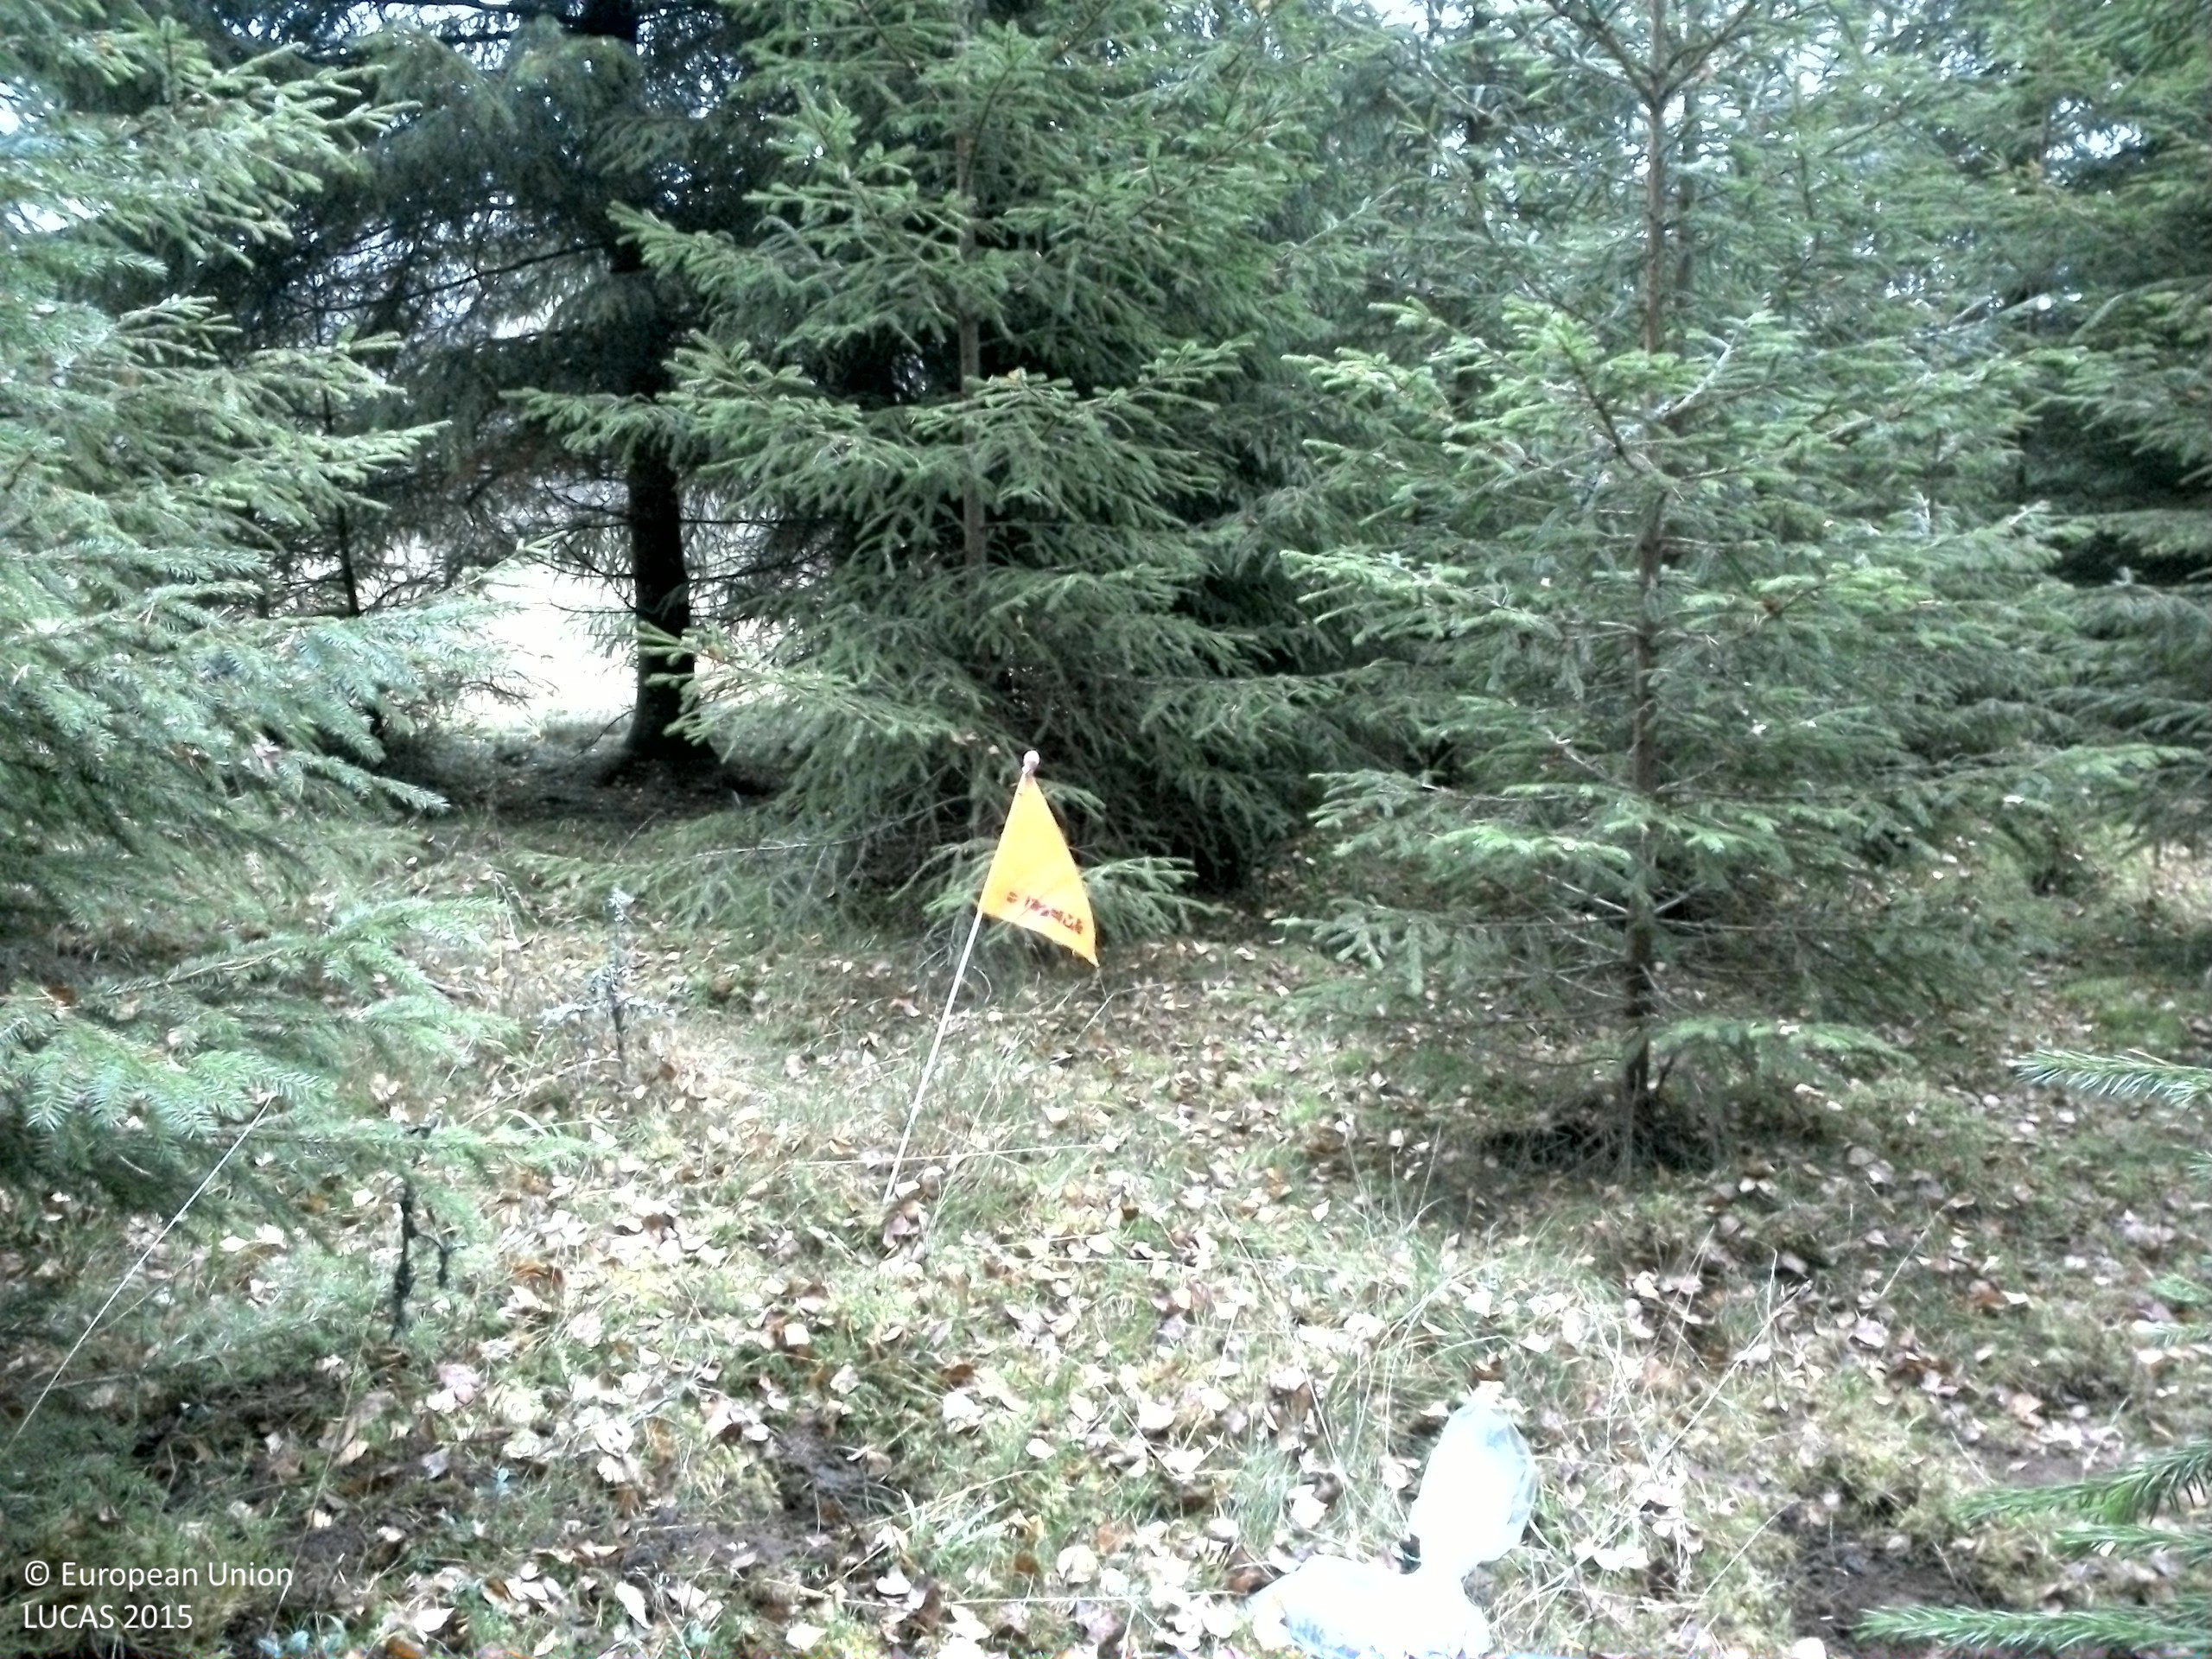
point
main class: Woodland
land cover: Spruce dominated coniferous woodland
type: boreal forest
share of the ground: > 75 %
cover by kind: coniferous forest trees 75 %, herbaceous plants 10 %, lichens and mosses 10 %, shrubs 5 %
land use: Forestry
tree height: > 5 m
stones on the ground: < 10 %
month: November
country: SE
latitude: 57.8648
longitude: 14.7652
